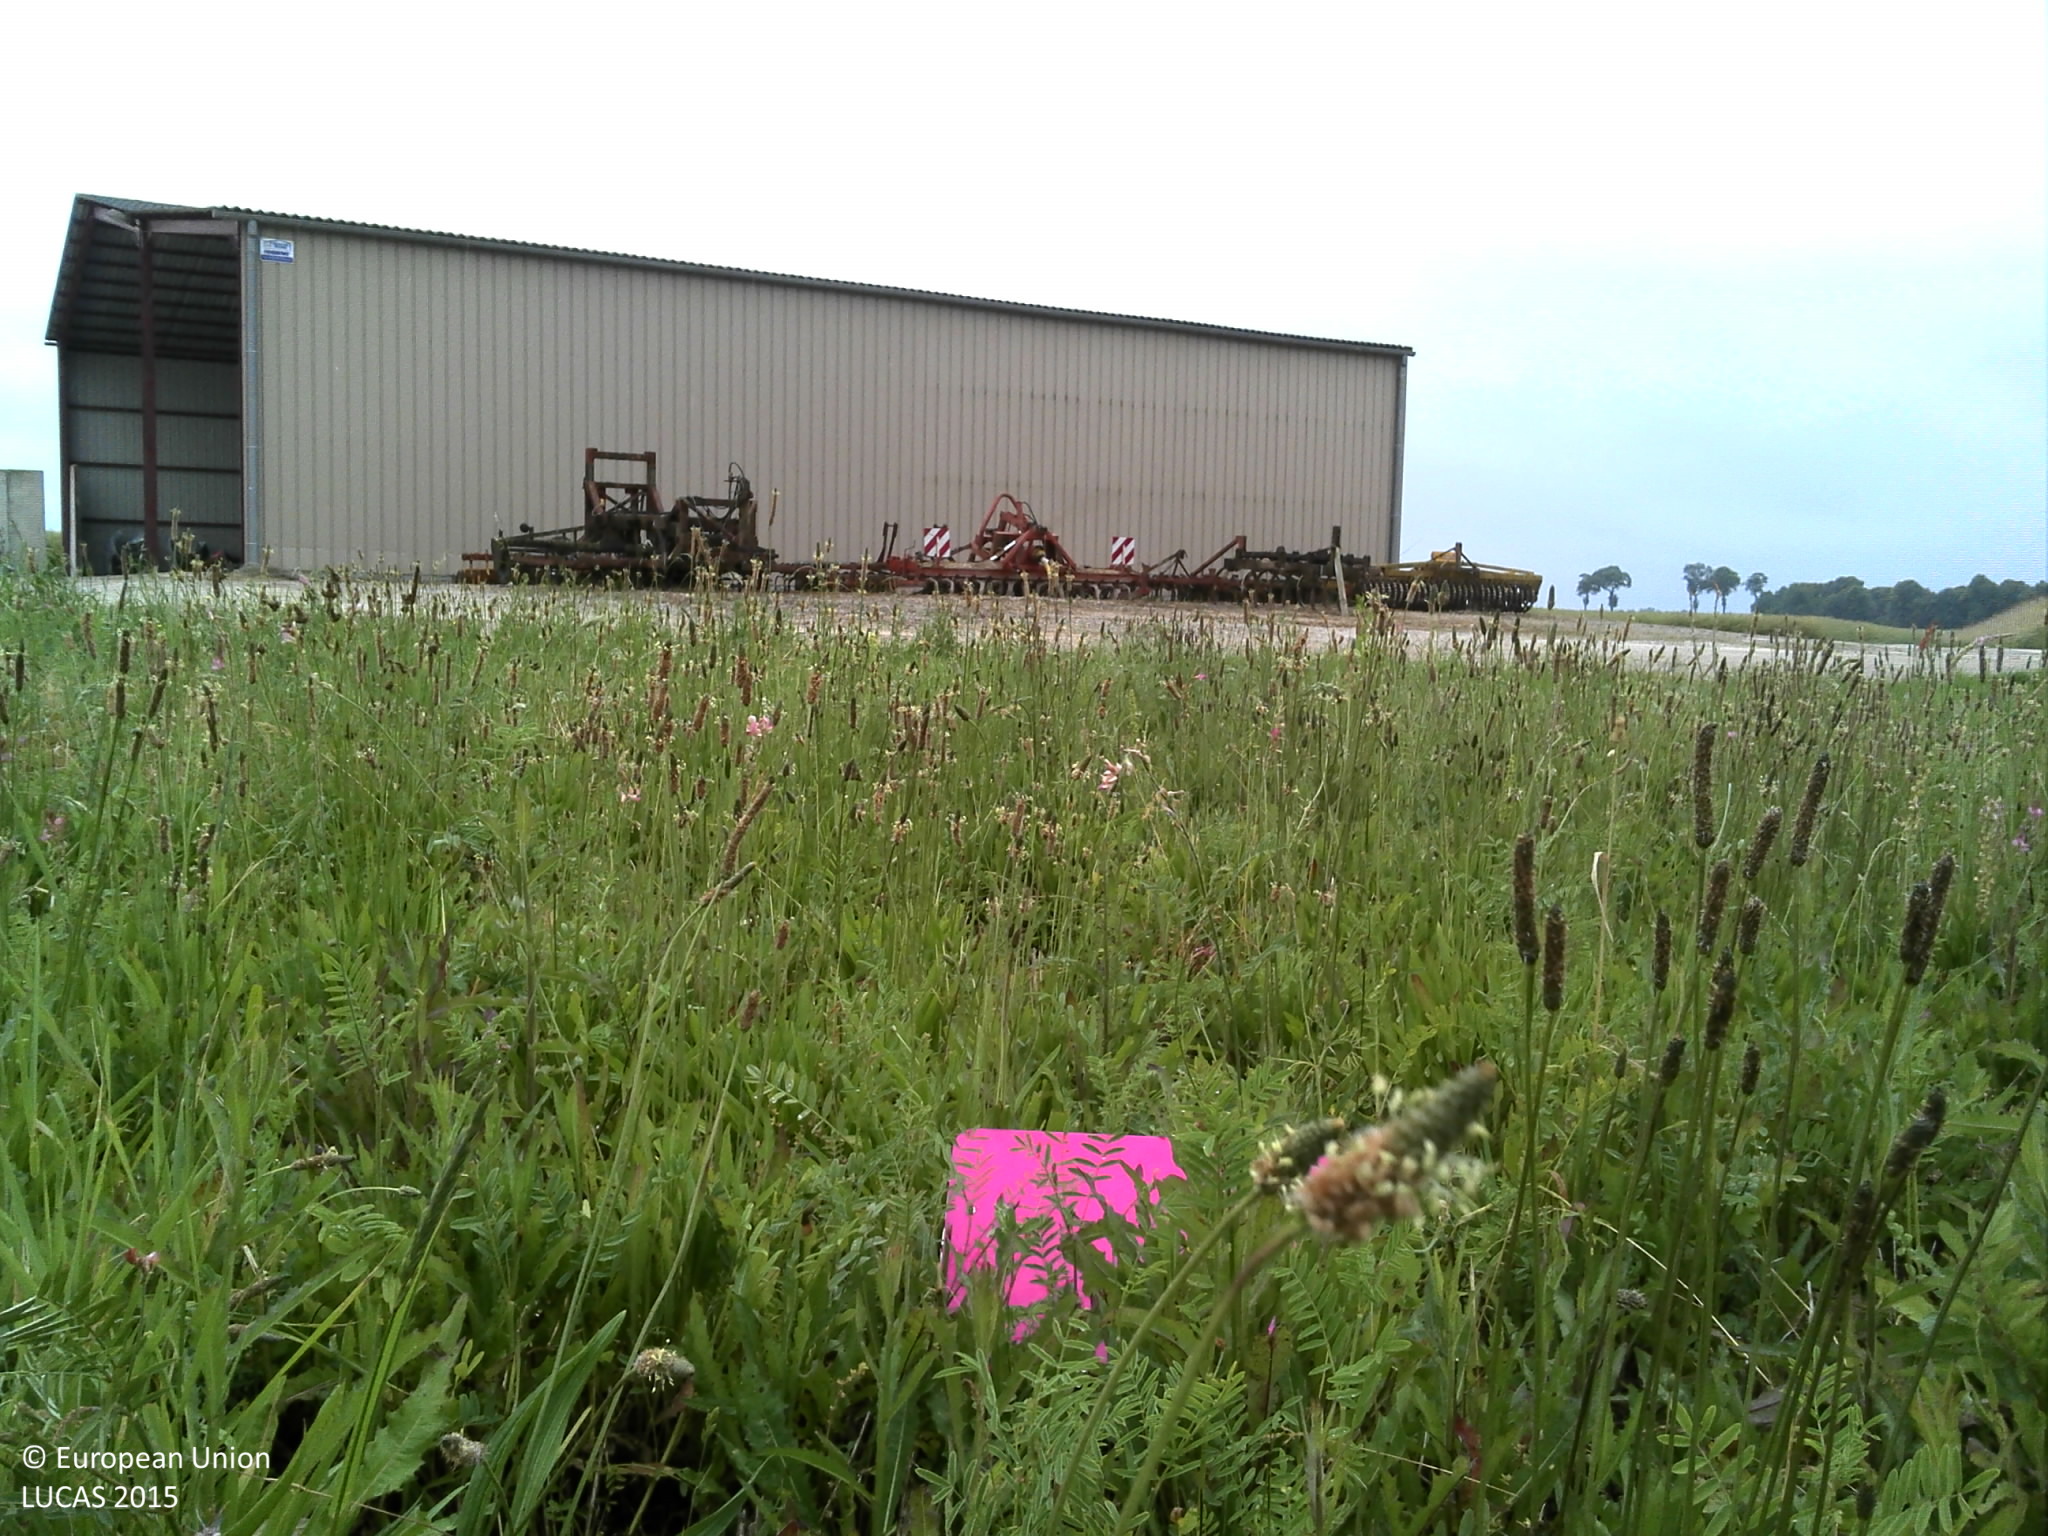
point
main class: Grassland
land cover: Spontaneously vegetated surfaces
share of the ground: > 75 %
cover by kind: herbaceous plants 80 %, lichens and mosses 10 %, consolidated bare surface 10 %
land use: Semi-natural and natural areas not in use
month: June
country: FR
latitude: 48.6660
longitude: 4.1983
